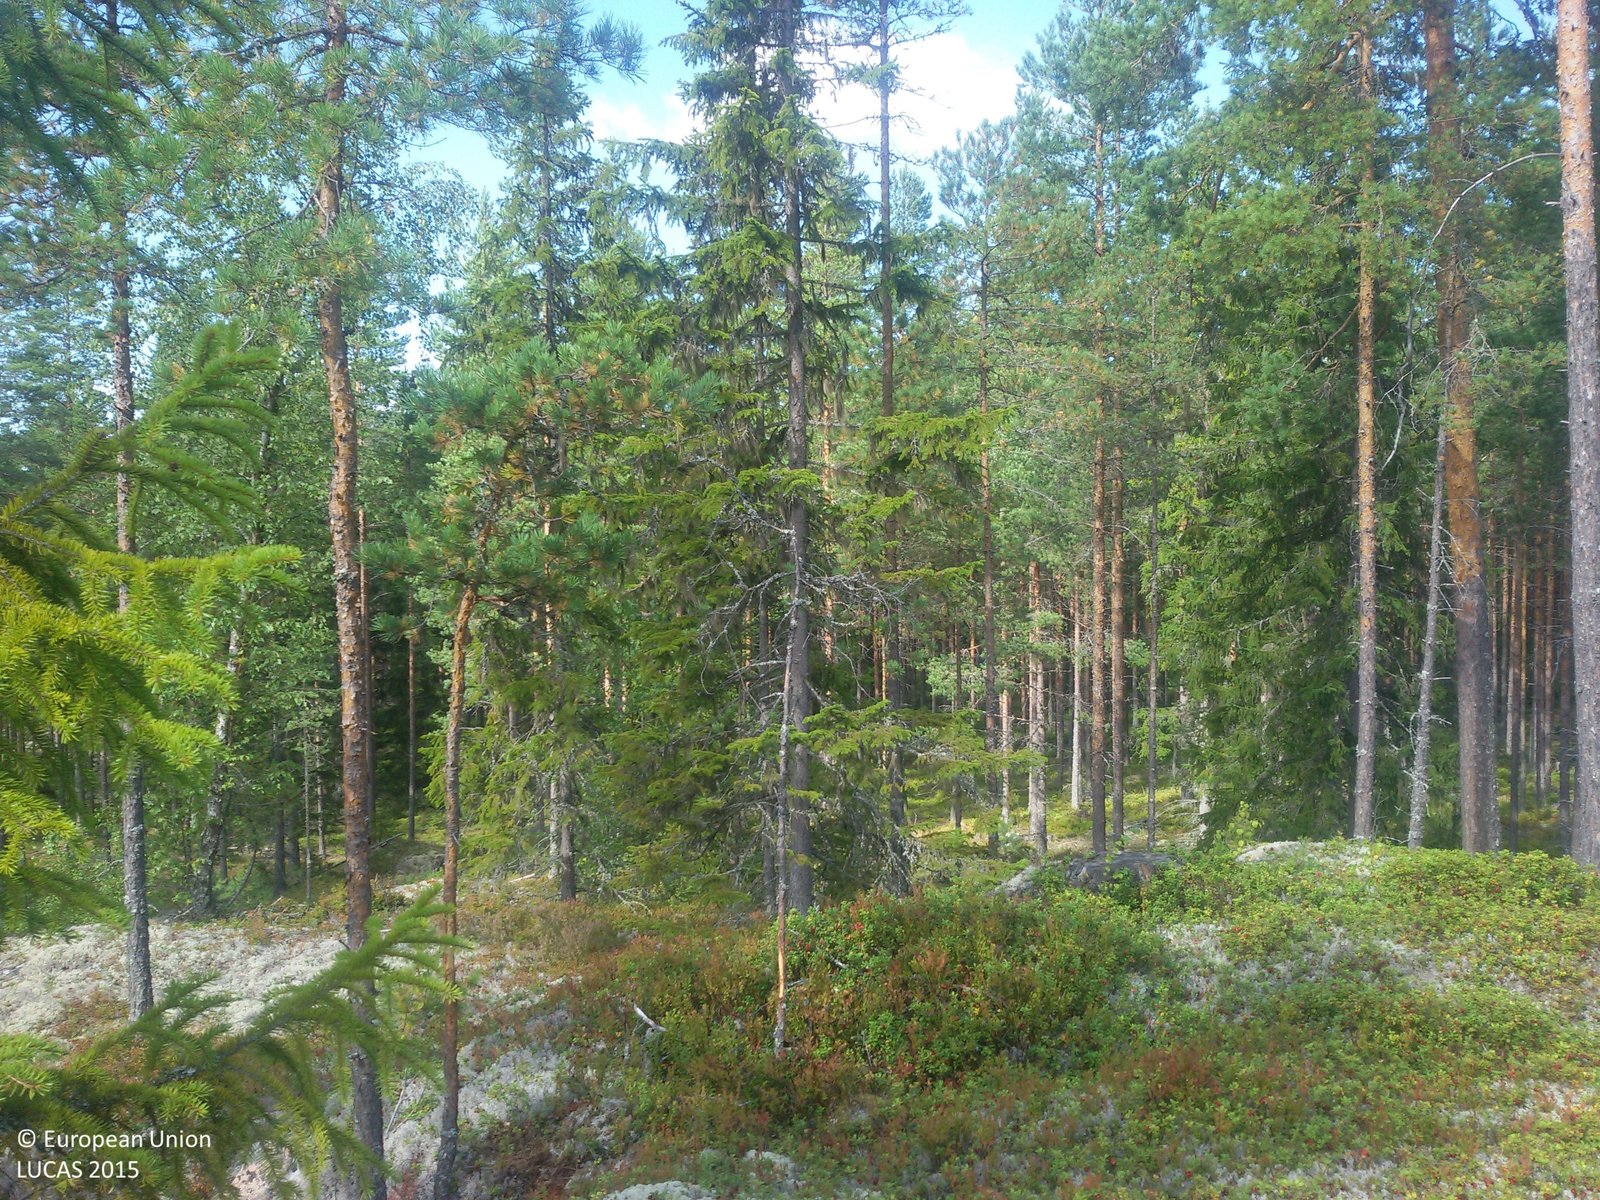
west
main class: Woodland
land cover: Pine dominated mixed woodland
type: boreal forest
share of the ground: 50 - 75 %
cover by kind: herbaceous plants 35 %, coniferous forest trees 30 %, broadleaved forest trees 20 %, lichens and mosses 15 %
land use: Forestry
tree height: < 5 m
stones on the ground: > 50 %
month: August
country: SE
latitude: 60.6952
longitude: 15.7565
